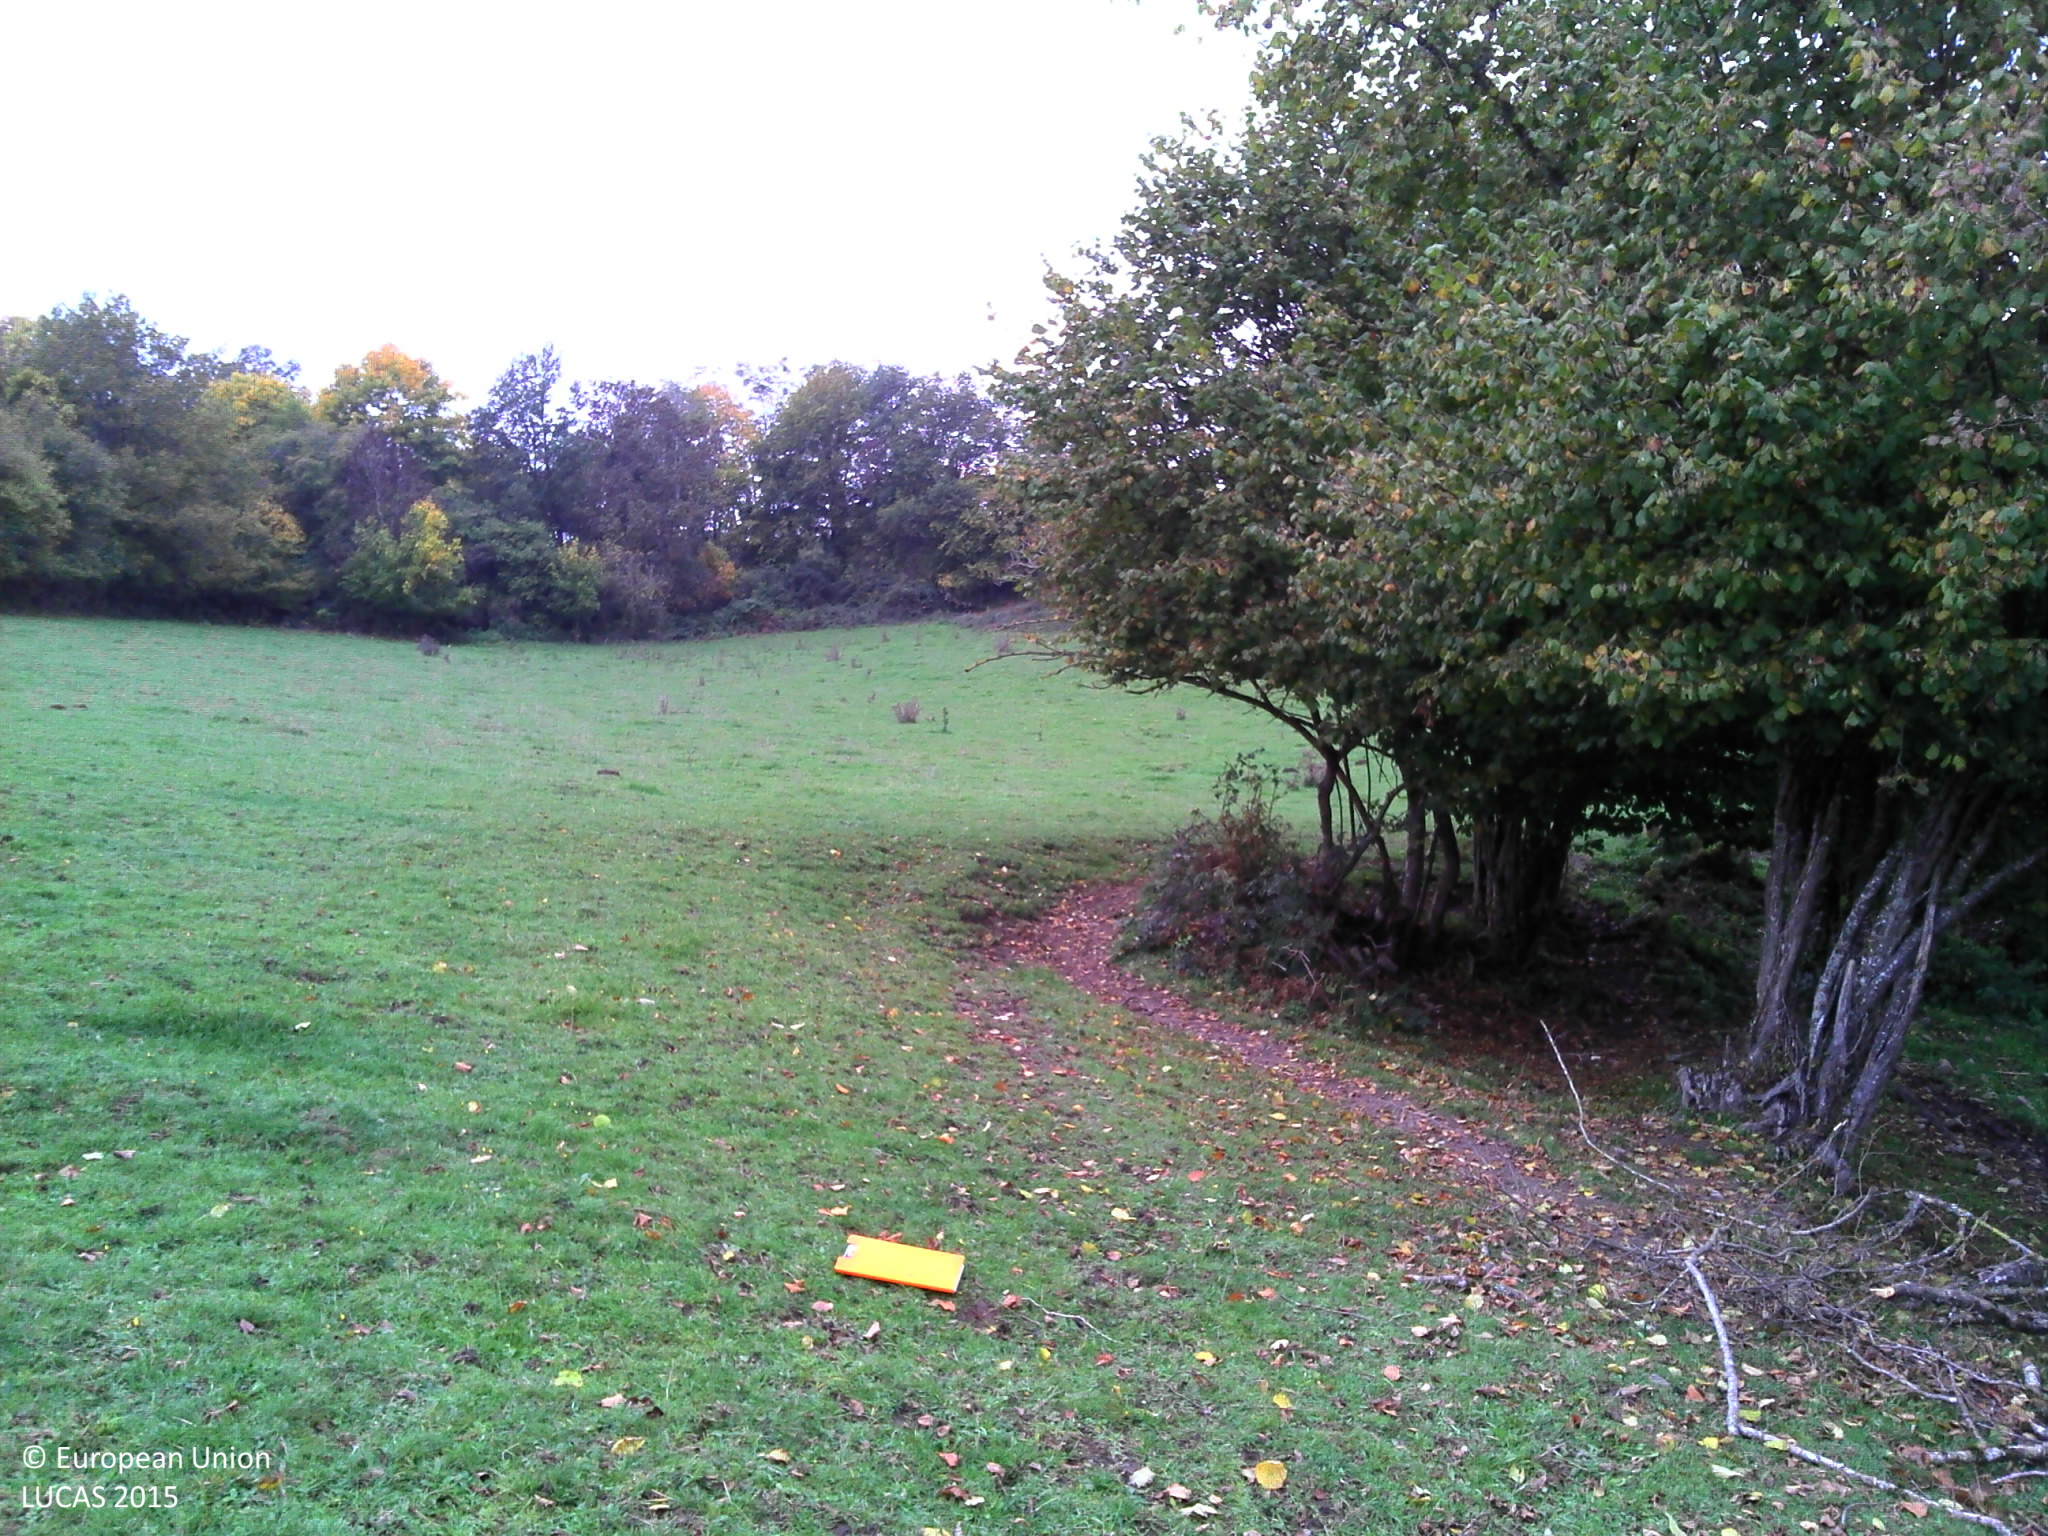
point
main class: Grassland
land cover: Grassland without tree/shrub cover
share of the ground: > 75 %
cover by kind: herbaceous plants 90 %, unconsolidated bare surface 10 %
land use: Agriculture (excluding fallow land and kitchen gardens)
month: October
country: FR
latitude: 46.0217
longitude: 2.8547
